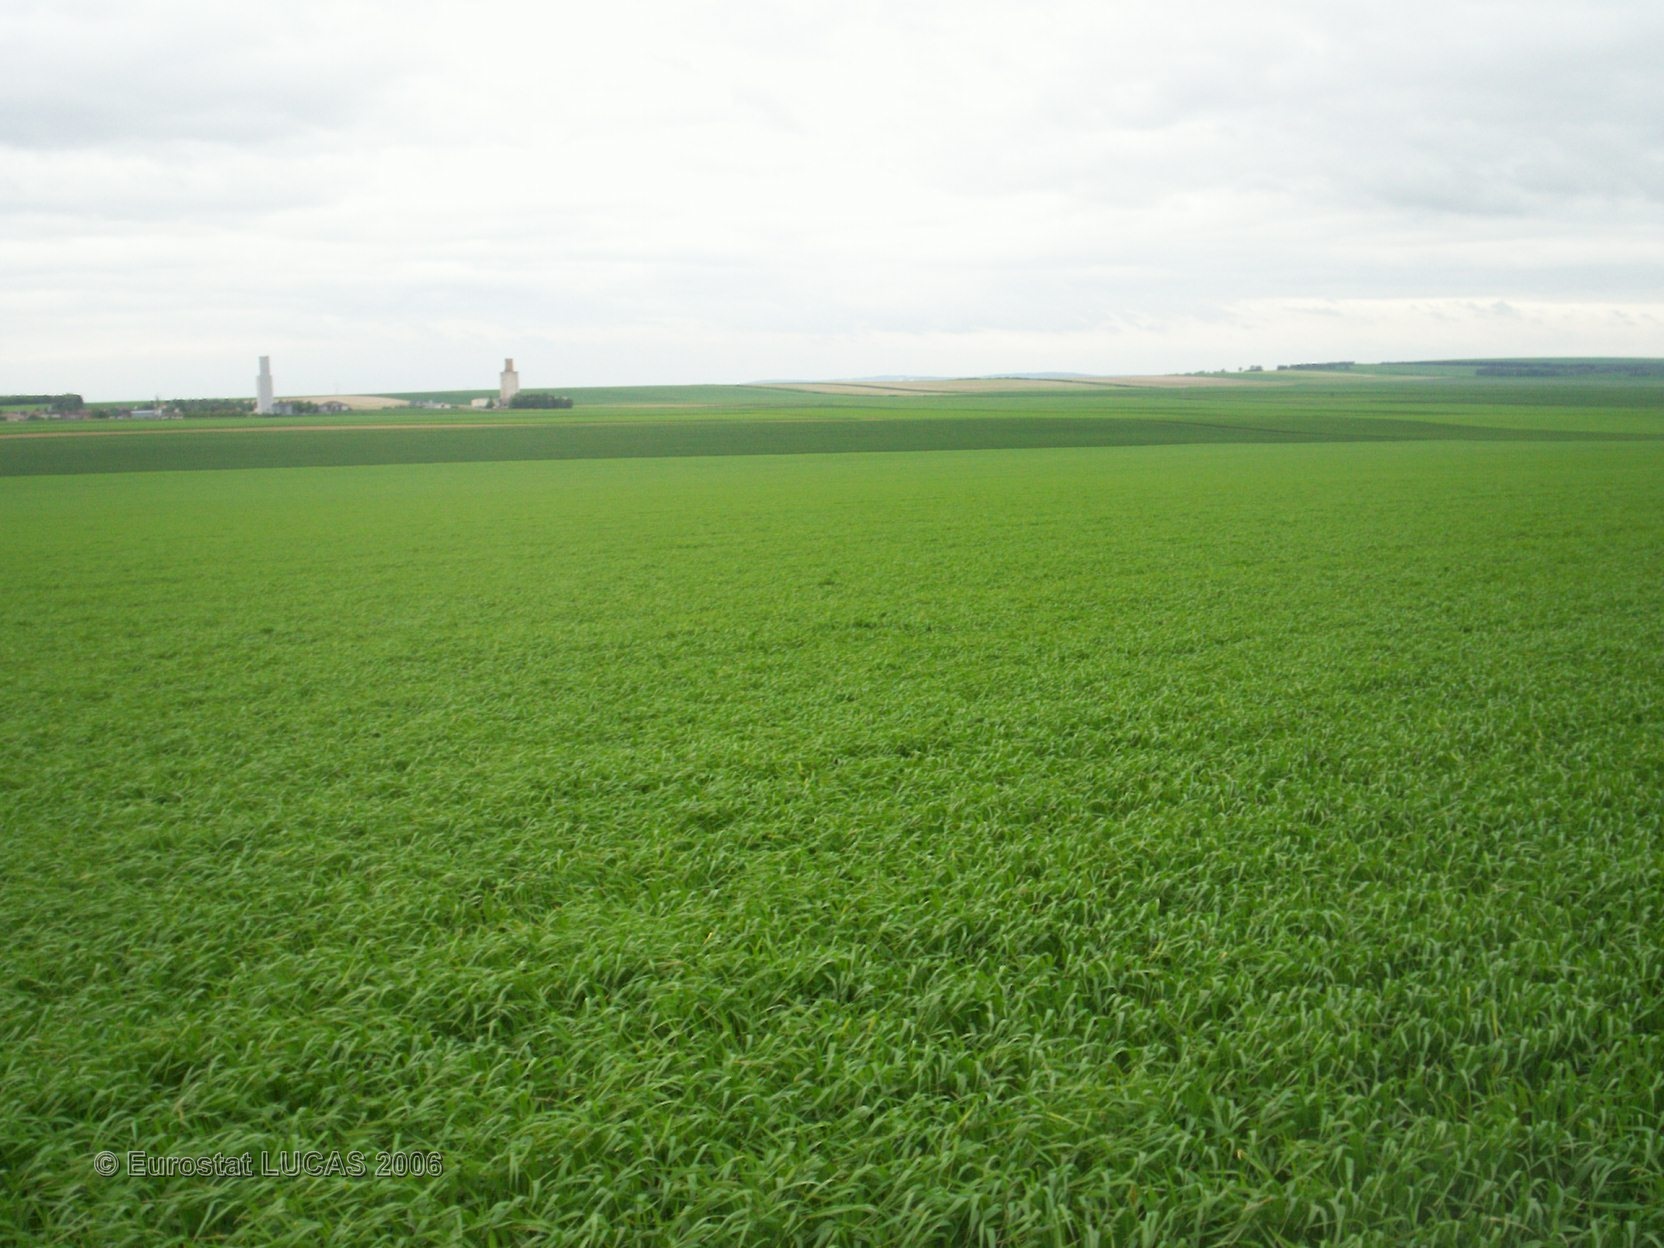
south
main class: Cropland
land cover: Barley
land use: Agriculture (excluding fallow land and kitchen gardens)
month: May
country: FR
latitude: 49.3598
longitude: 4.3646
